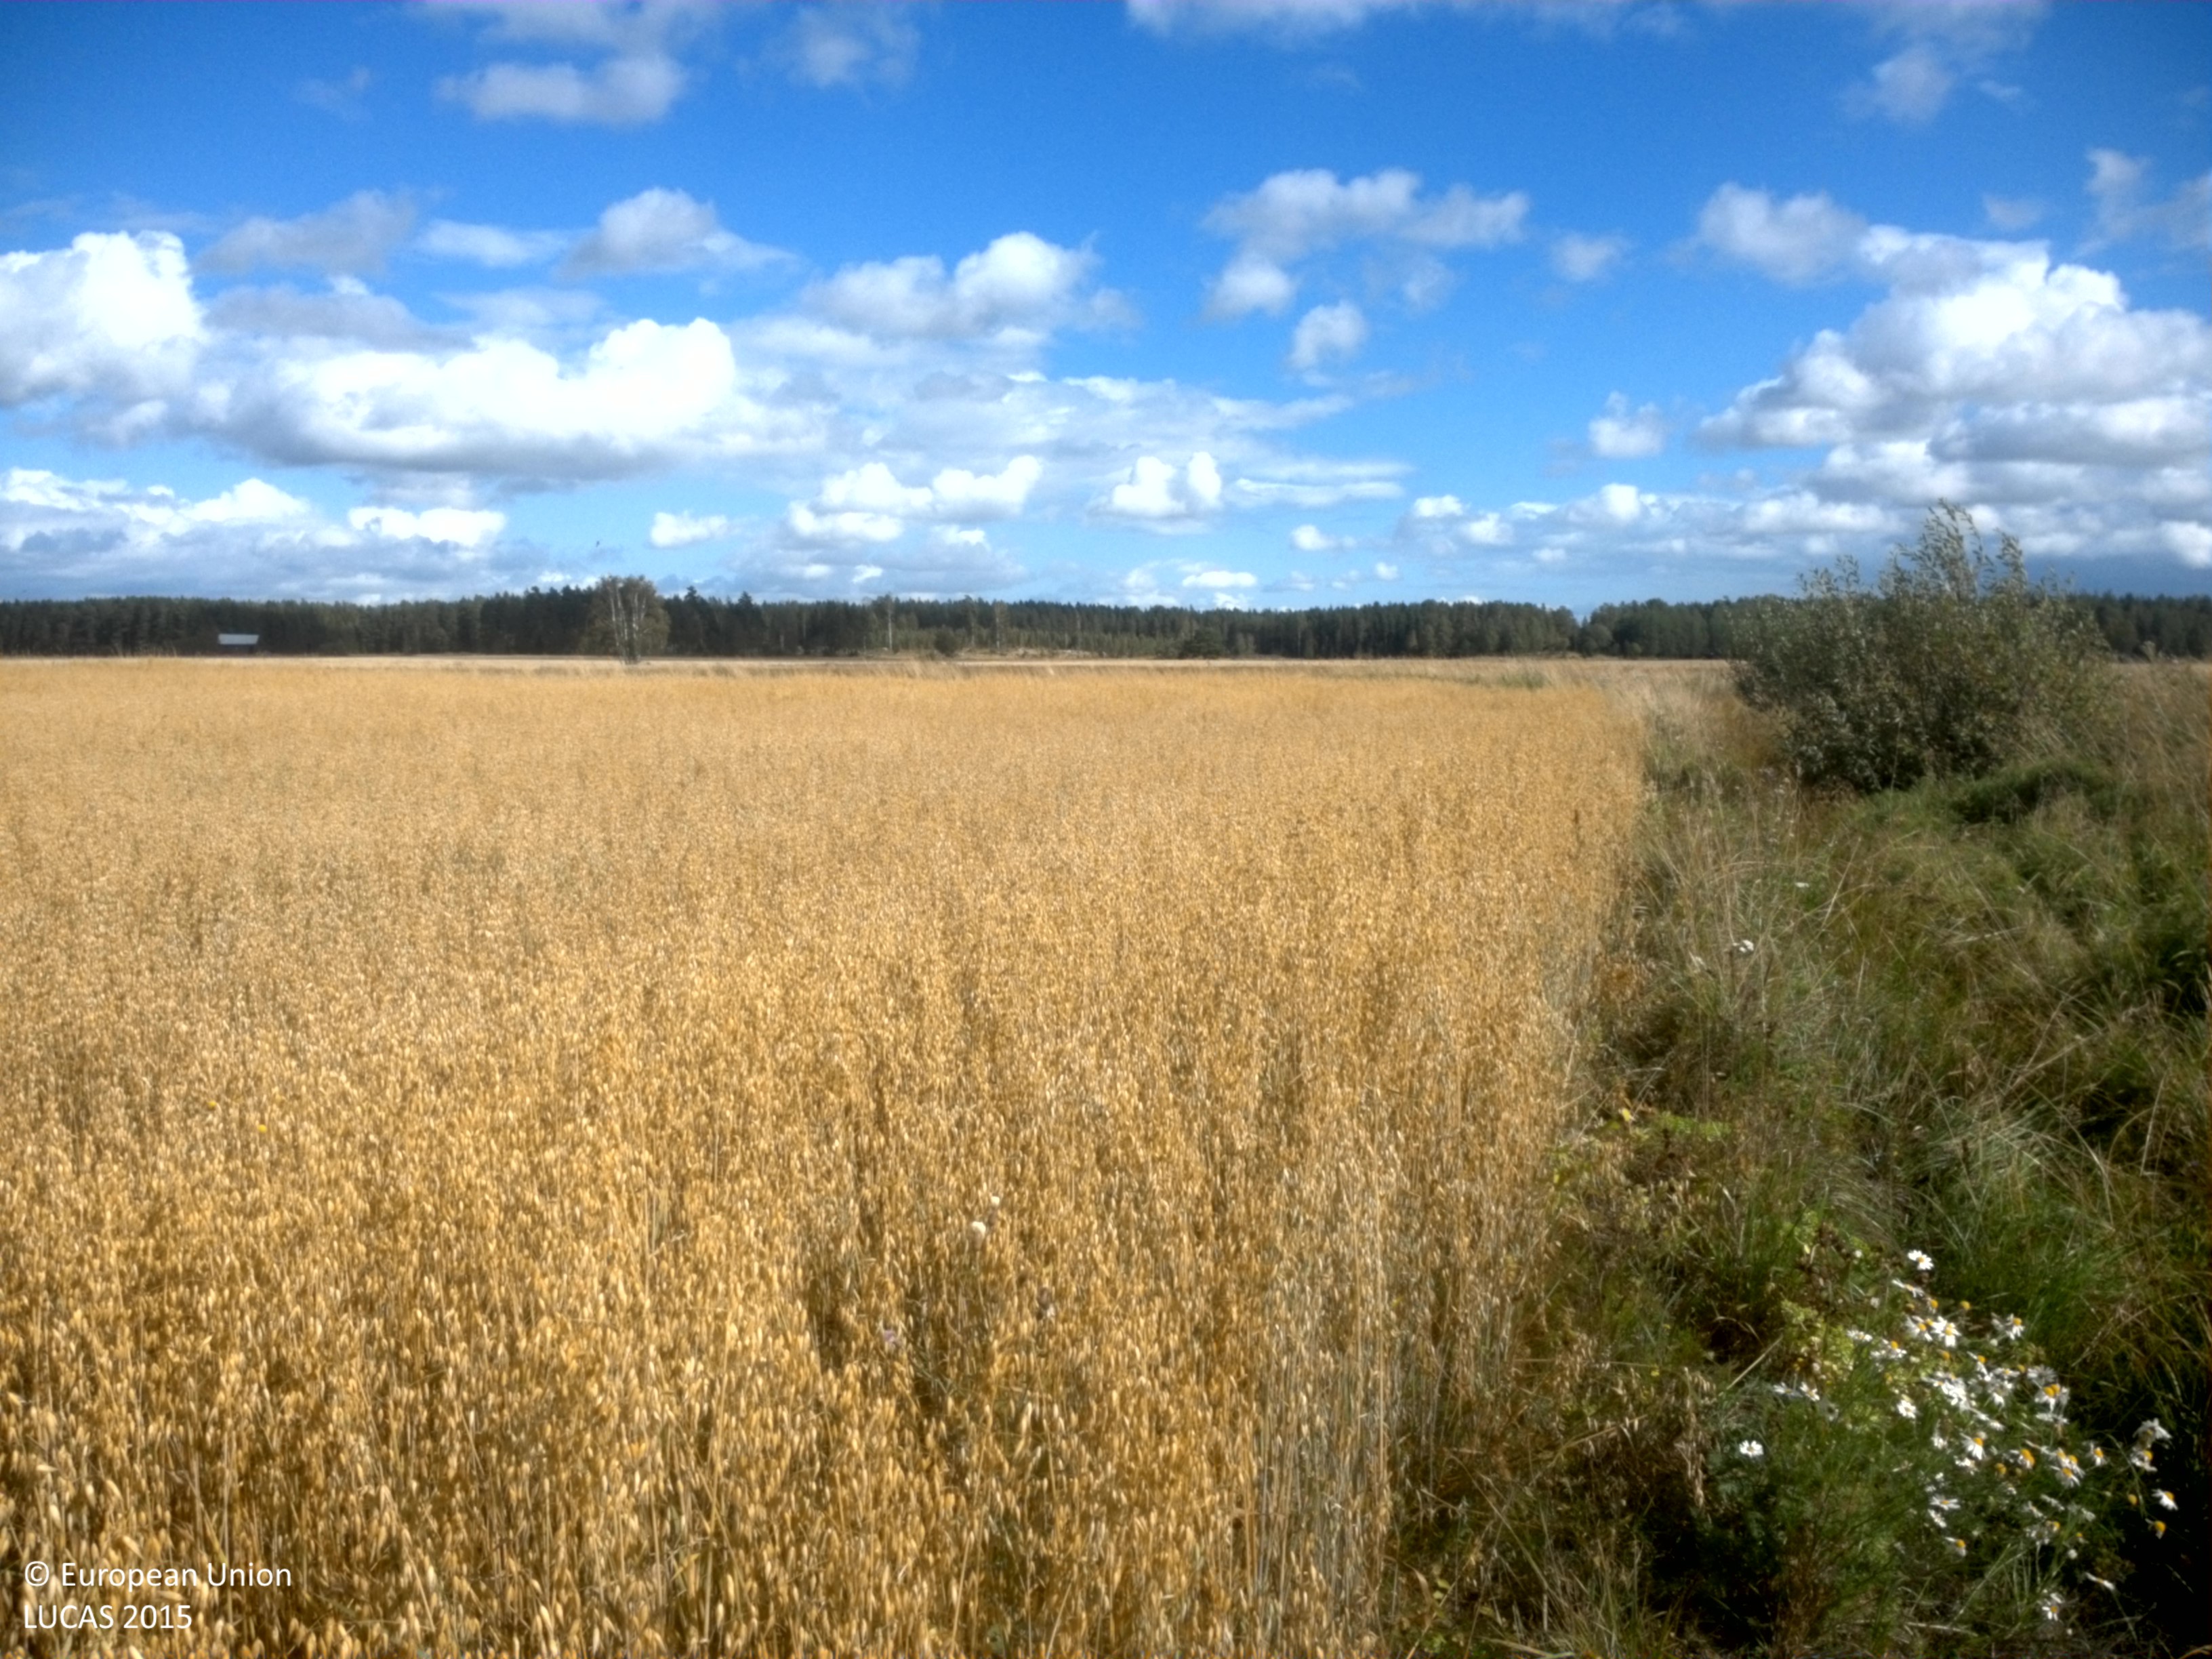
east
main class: Cropland
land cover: Oats
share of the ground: > 75 %
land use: Agriculture (excluding fallow land and kitchen gardens)
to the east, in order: Ditches and canals; Oats; Grass margins; Paved roads, cycling and walking lanes; Spontaneously vegetated surfaces; Grass margins; Ditches and canals; Grass margins
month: August
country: SE
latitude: 59.4702
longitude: 15.6919
